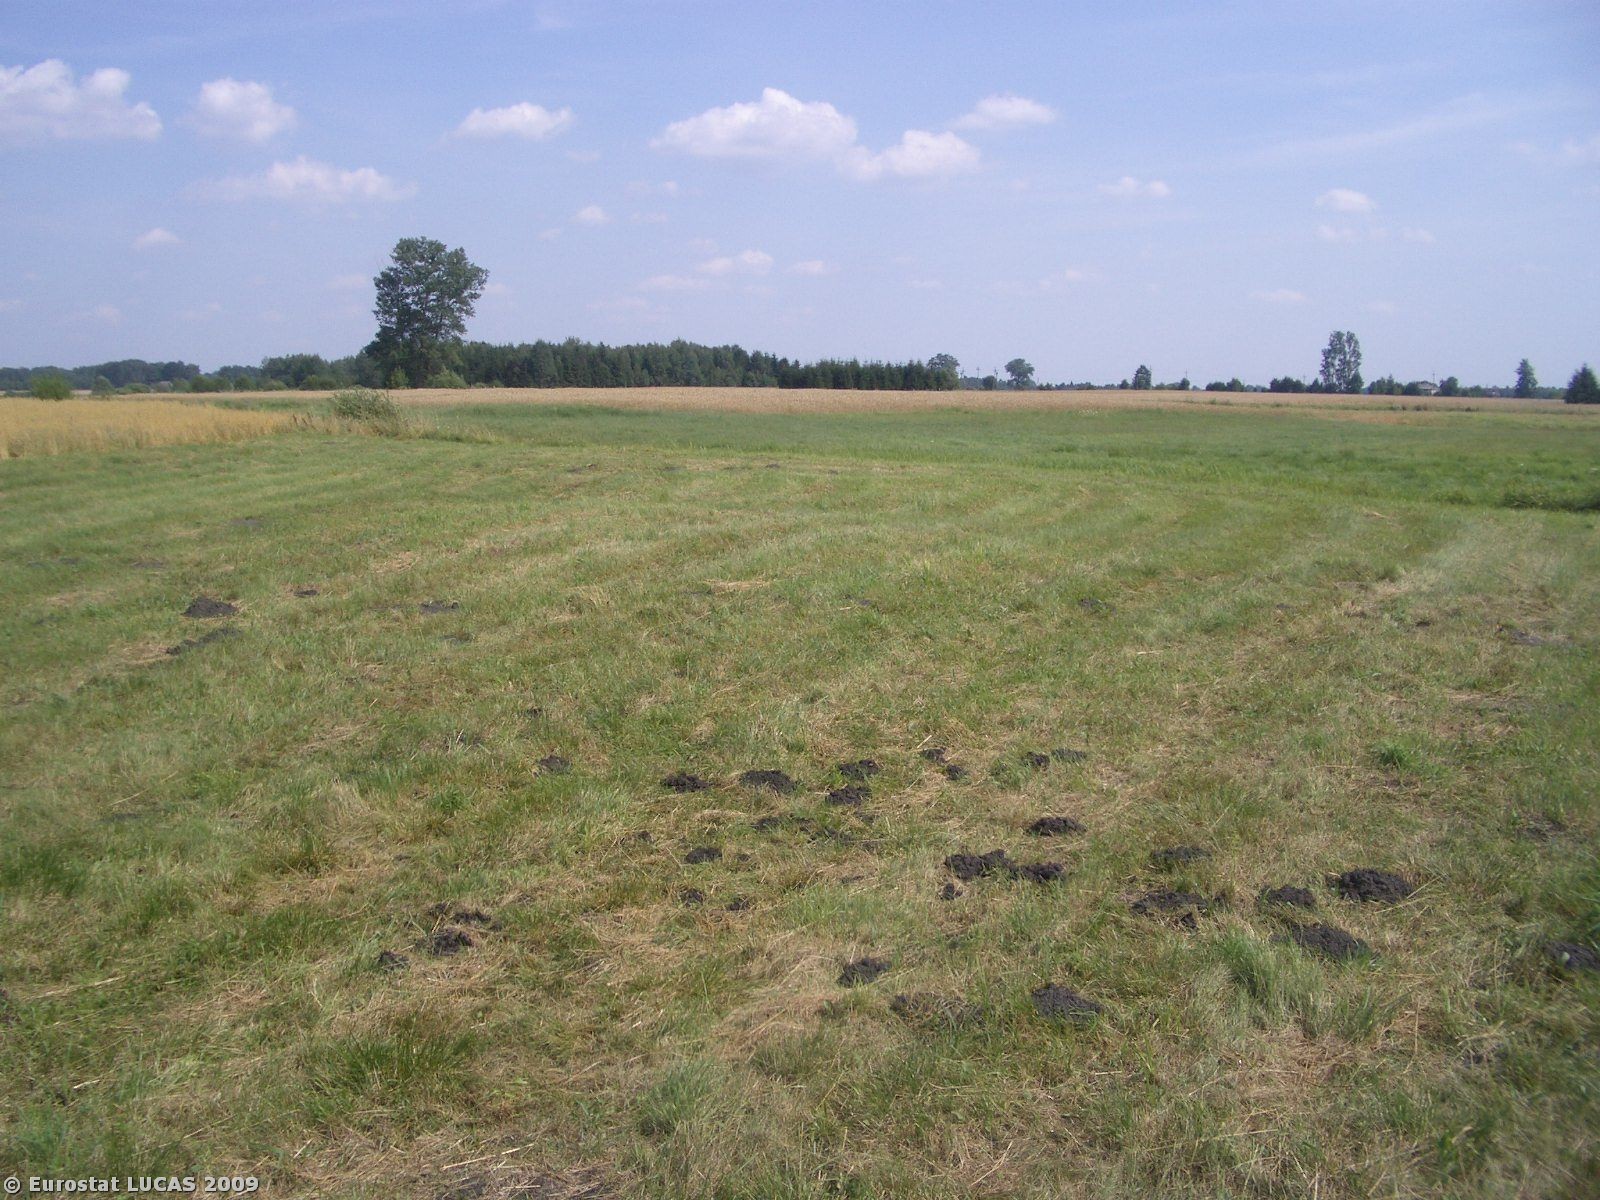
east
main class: Grassland
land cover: Grassland without tree/shrub cover
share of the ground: > 75 %
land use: Agriculture (excluding fallow land and kitchen gardens)
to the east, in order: Grassland without tree/shrub cover; Oats; Tracks; Barley; Grassland without tree/shrub cover
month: July
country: PL
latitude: 51.4471
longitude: 23.0988
